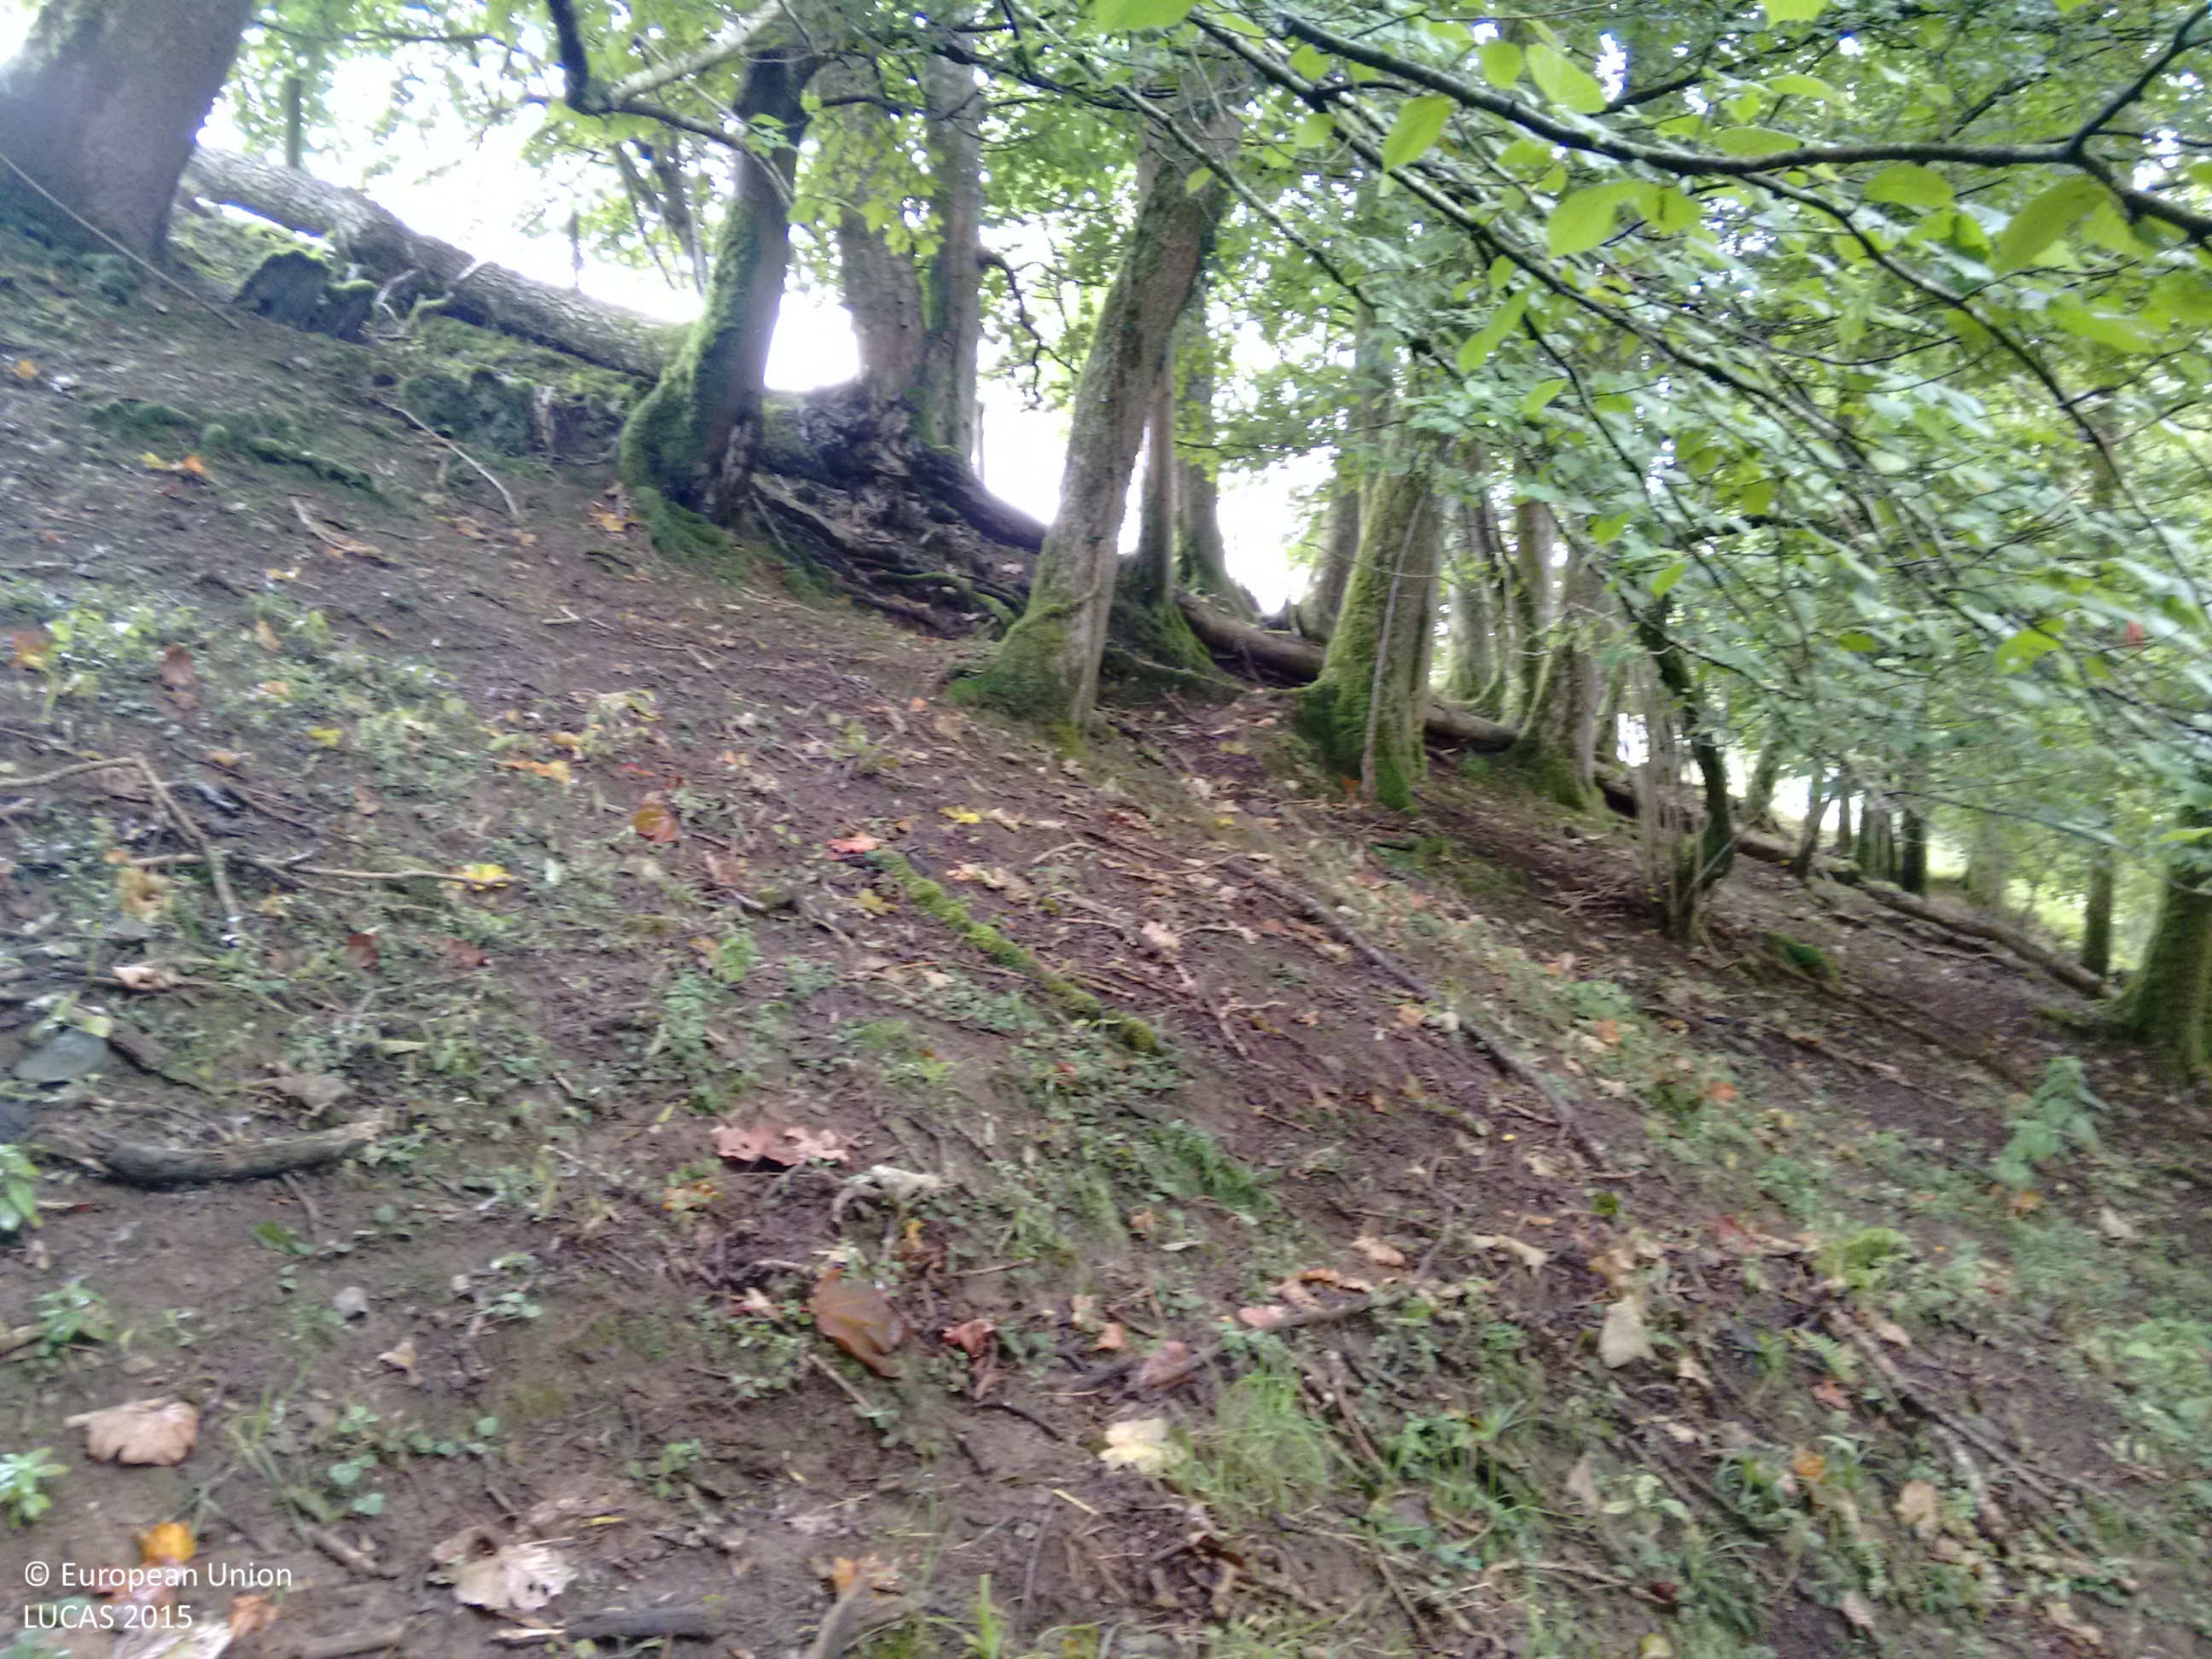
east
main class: Woodland
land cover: Broadleaved woodland
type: mesophytic deciduous forest
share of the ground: > 75 %
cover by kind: broadleaved forest trees 70 %, shrubs 20 %, consolidated bare surface 10 %
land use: Semi-natural and natural areas not in use
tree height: > 5 m
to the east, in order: Broadleaved woodland; Fences; Grassland without tree/shrub cover; Fences; Single bushes/trees; Grassland without tree/shrub cover
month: September
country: GB
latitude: 51.9978
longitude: -3.8556
